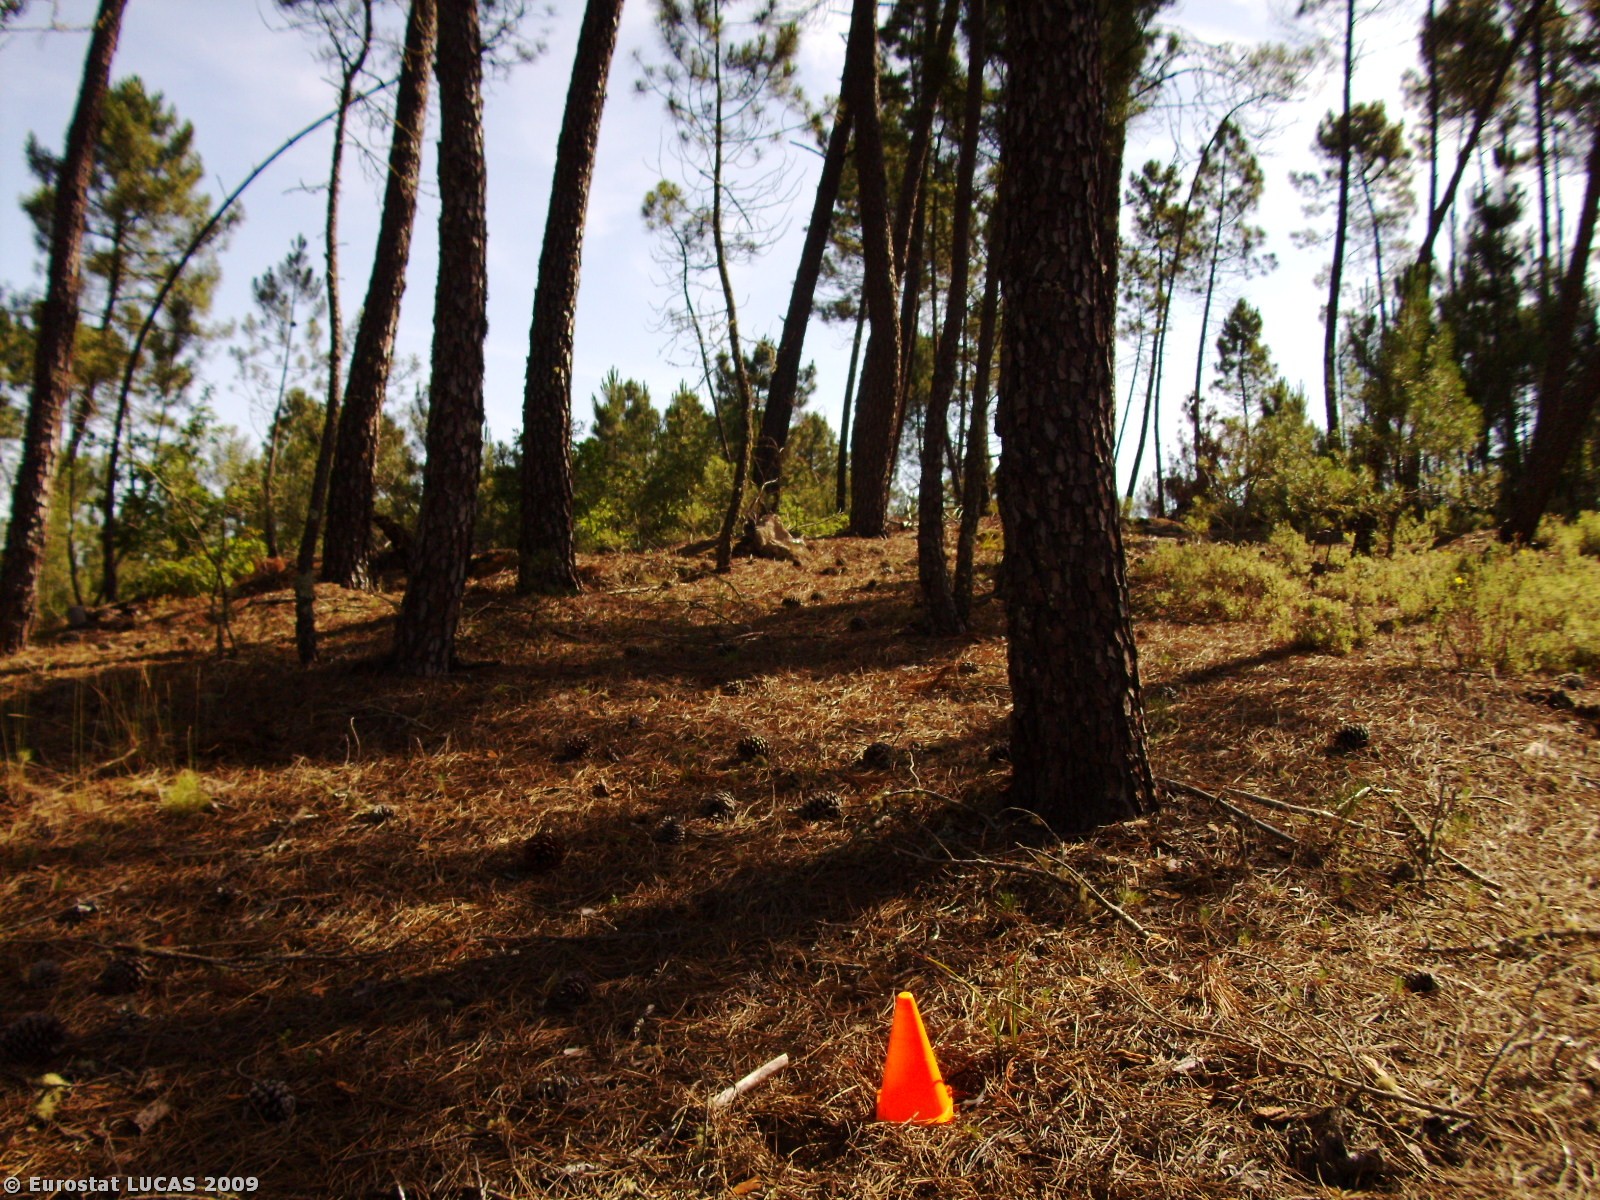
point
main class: Woodland
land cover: Coniferous woodland
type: coniferous forest of the mediterranean region
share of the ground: > 75 %
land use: Forestry
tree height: > 5 m
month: July
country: PT
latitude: 40.7686
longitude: -7.6897
